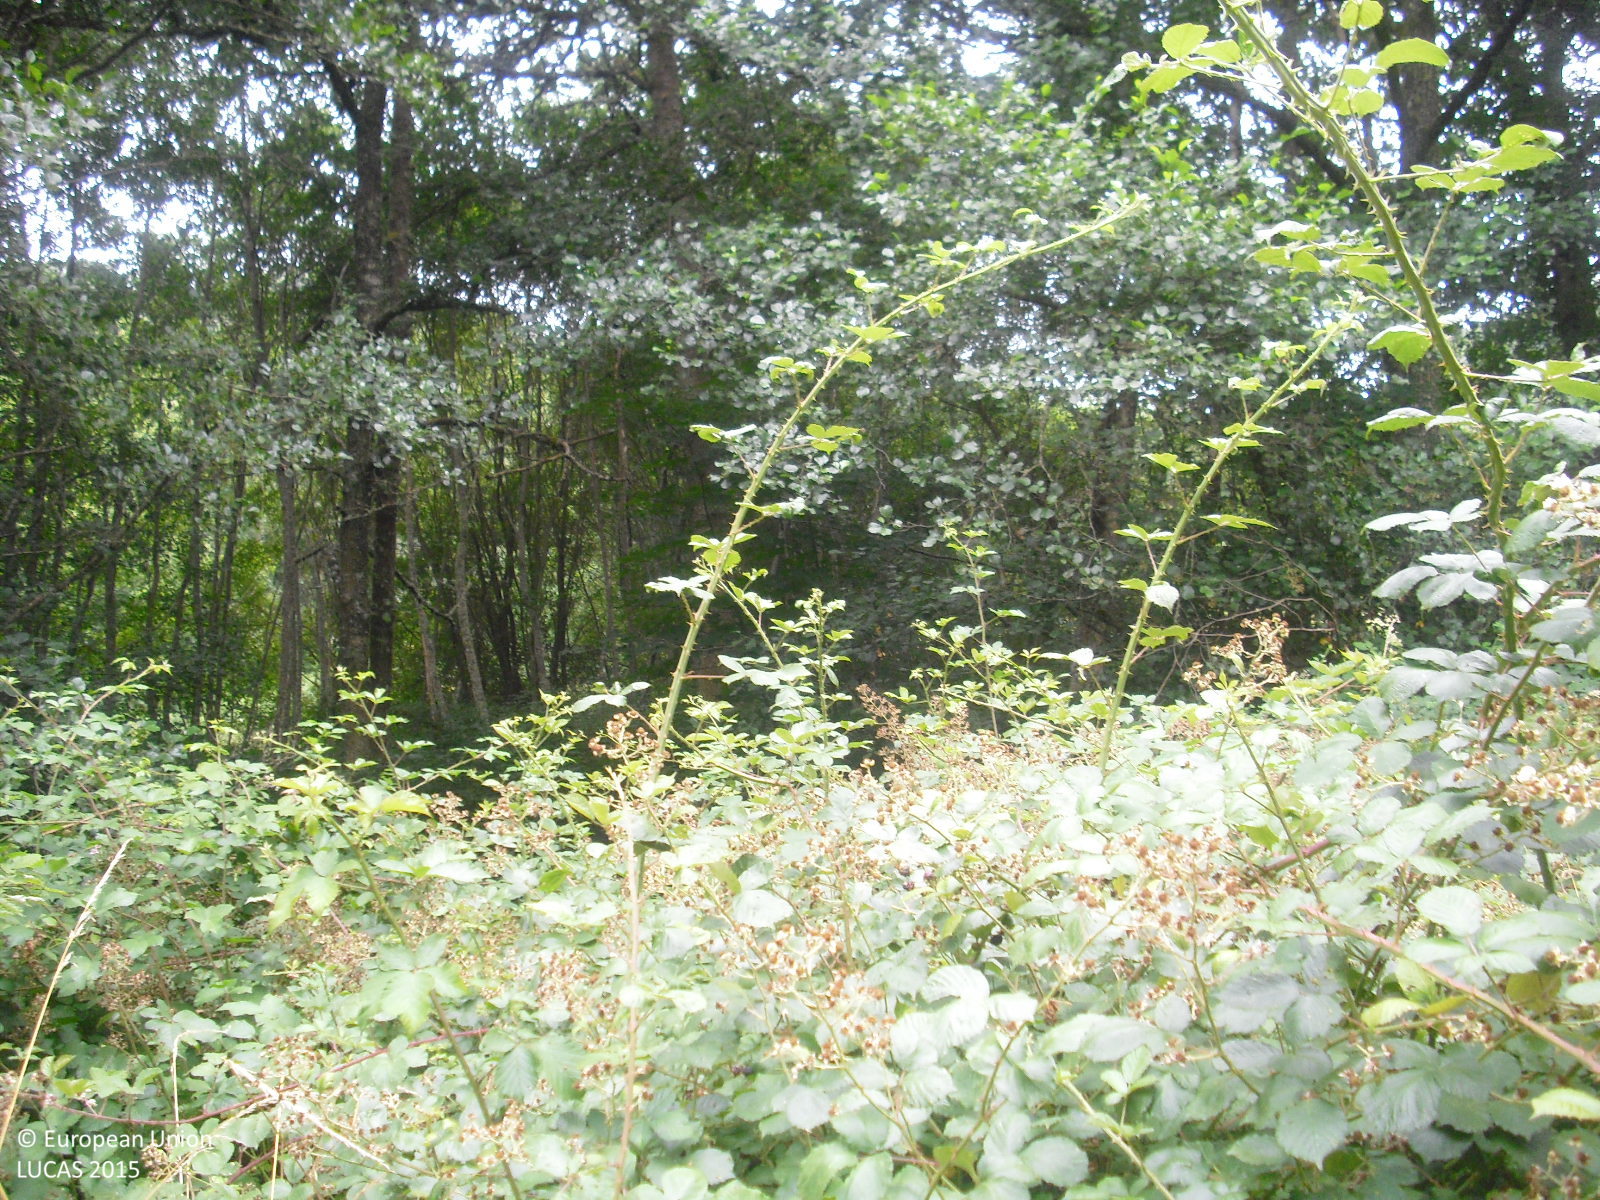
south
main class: Shrubland
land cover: Shrubland without tree cover
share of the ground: > 75 %
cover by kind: shrubs 70 %, herbaceous plants 30 %
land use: Abandoned areas
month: July
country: ES
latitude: 42.3754
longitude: -7.4696
